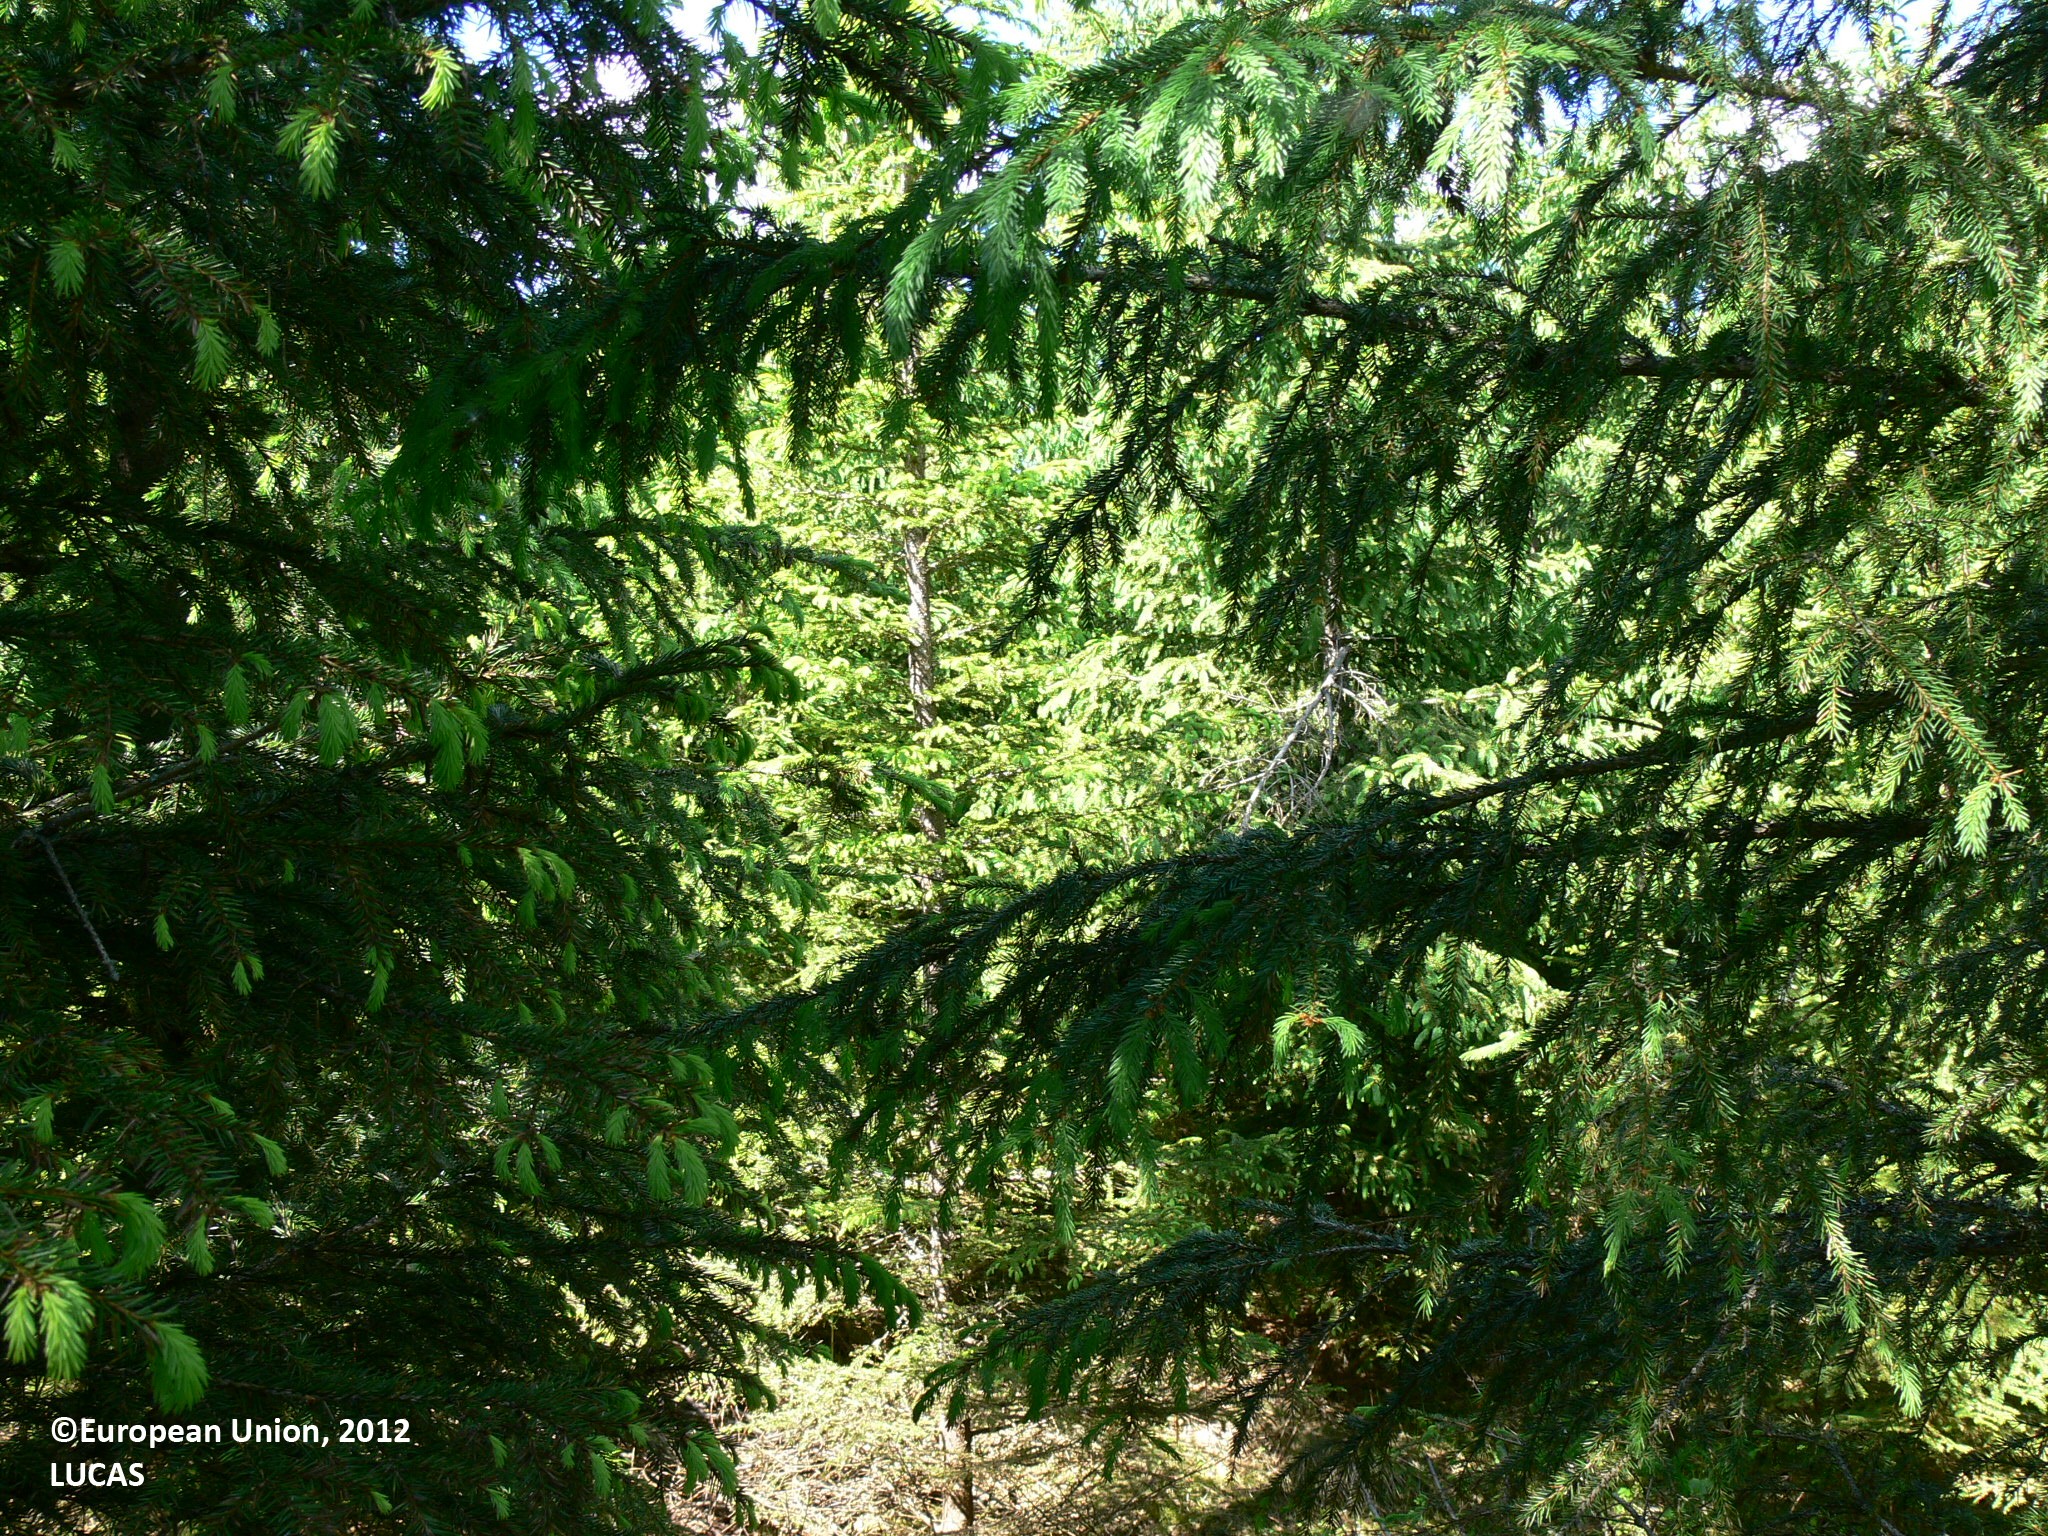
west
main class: Woodland
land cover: Spruce dominated coniferous woodland
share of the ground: > 75 %
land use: Forestry
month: June
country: FI
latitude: 62.3432
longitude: 30.4631
